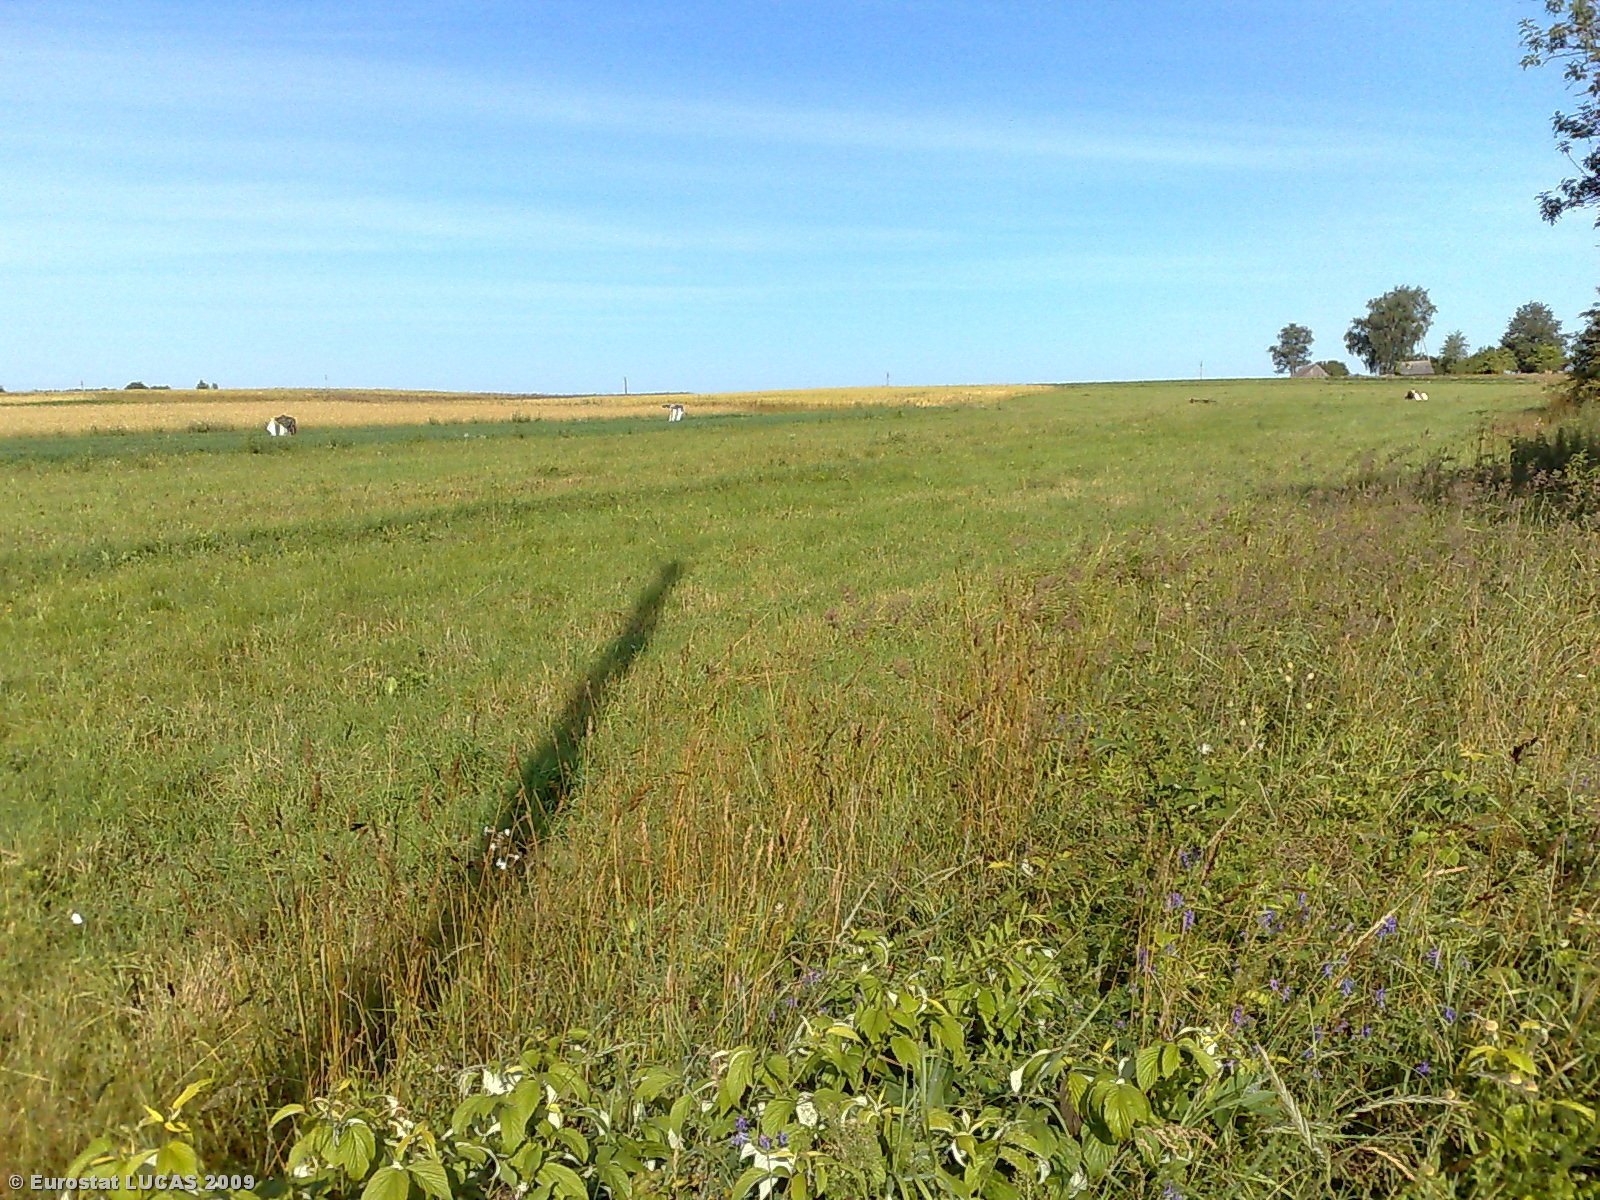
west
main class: Grassland
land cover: Grassland without tree/shrub cover
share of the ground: > 75 %
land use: Agriculture (excluding fallow land and kitchen gardens)
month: July
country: LT
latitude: 55.8296
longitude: 22.8534
